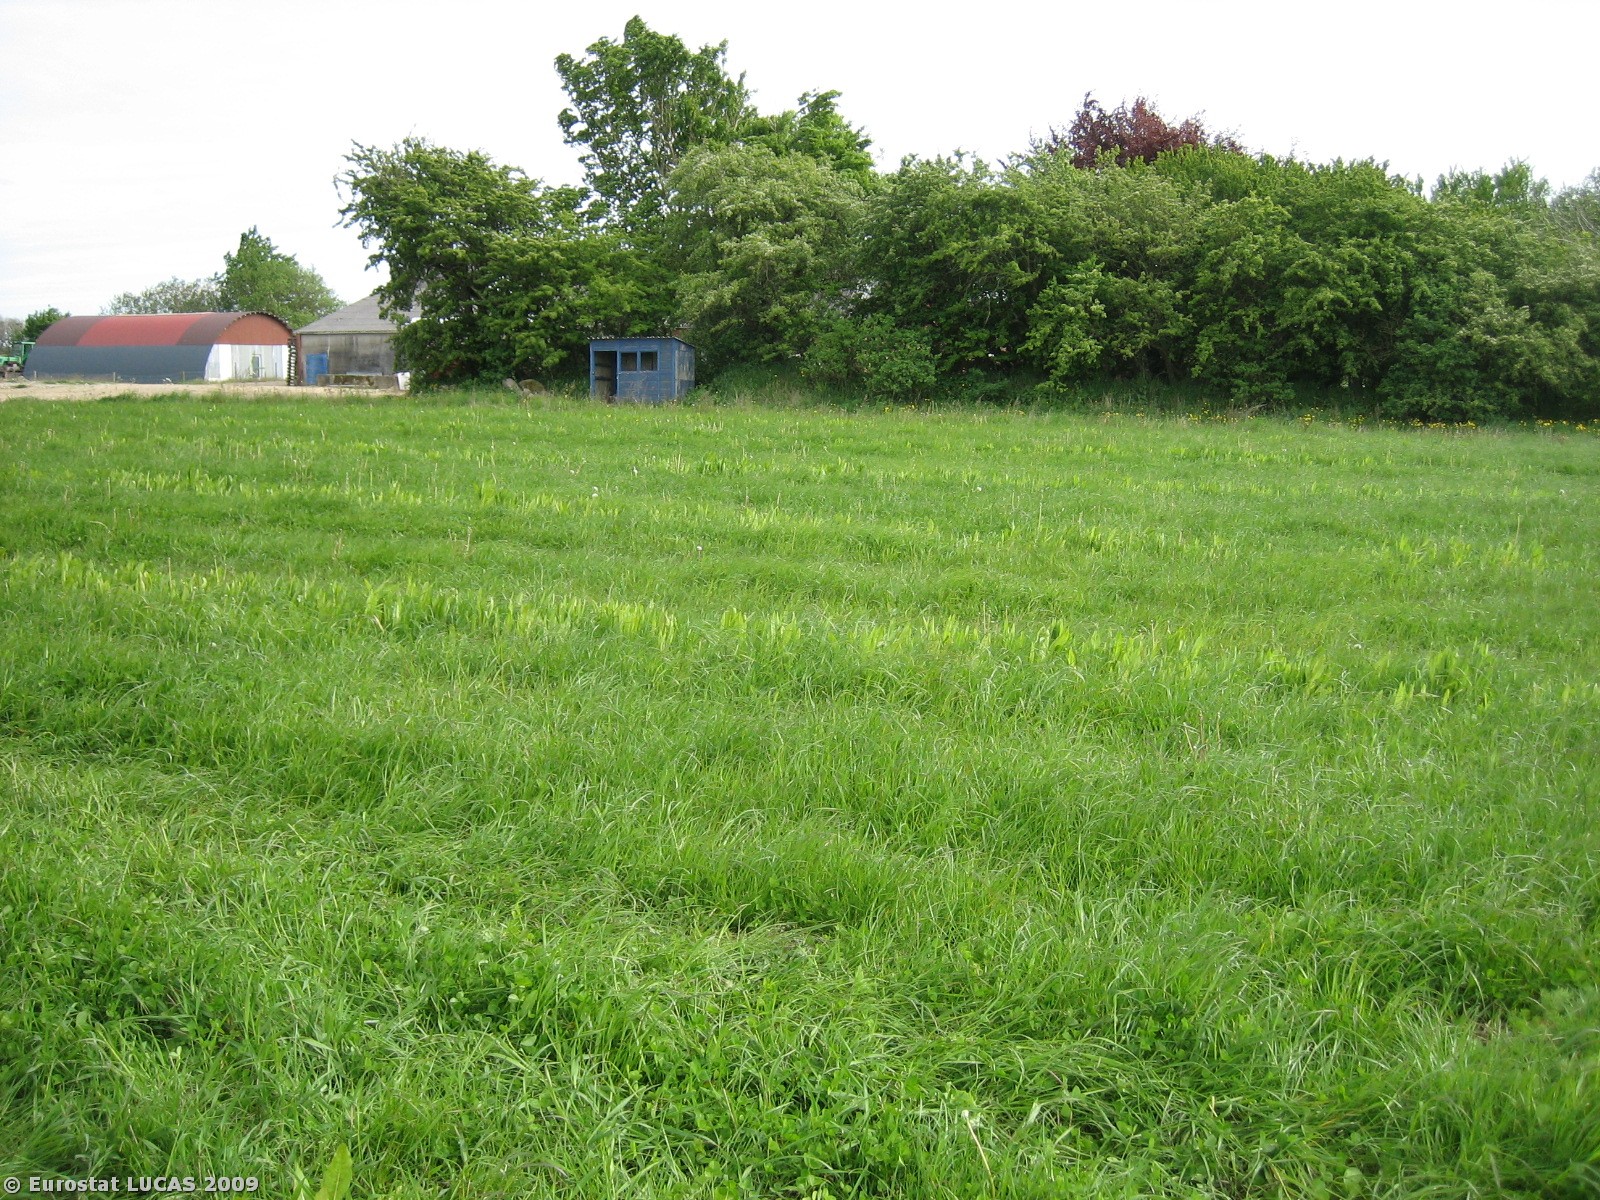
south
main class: Grassland
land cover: Grassland without tree/shrub cover
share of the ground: > 75 %
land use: Agriculture (excluding fallow land and kitchen gardens)
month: May
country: DK
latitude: 56.0341
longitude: 8.4128
